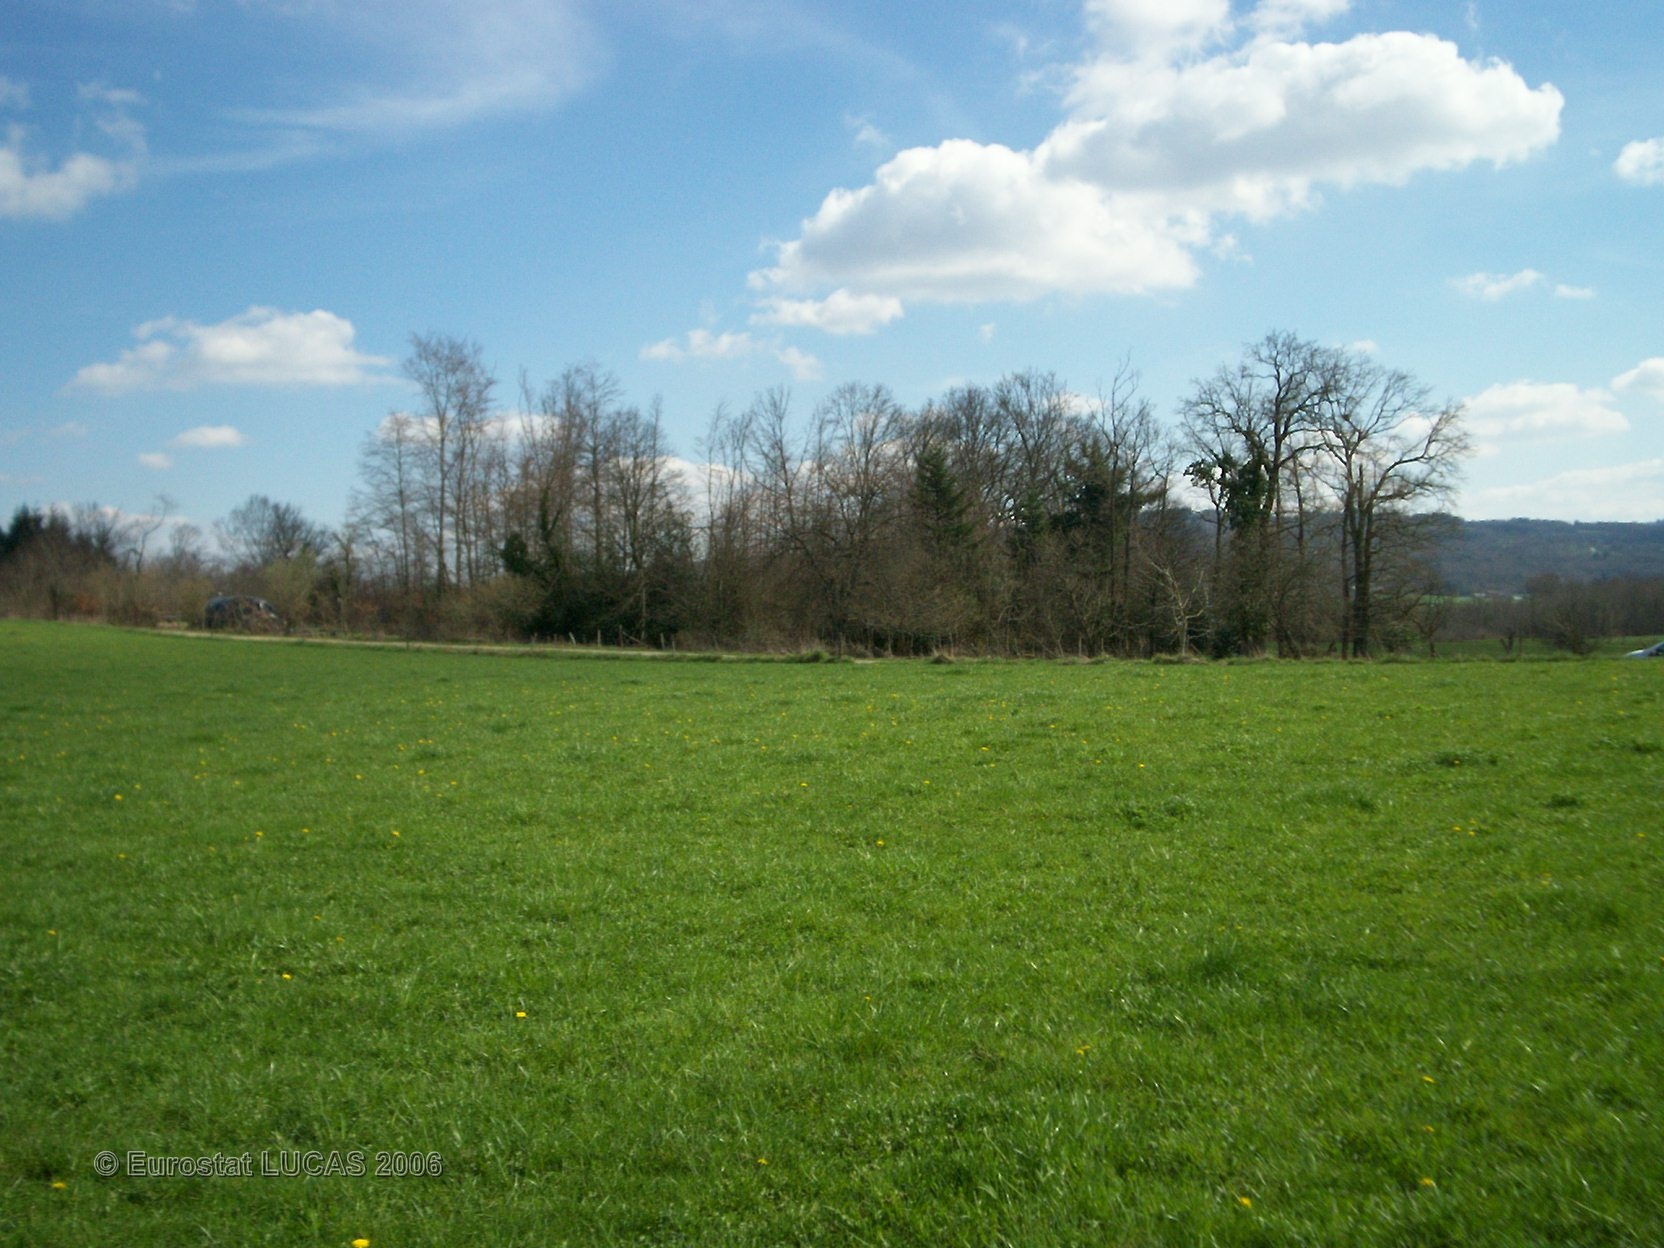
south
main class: Grassland
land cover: Grassland without tree/shrub cover
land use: Agriculture (excluding fallow land and kitchen gardens)
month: April
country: FR
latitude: 46.1043
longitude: 1.5177
